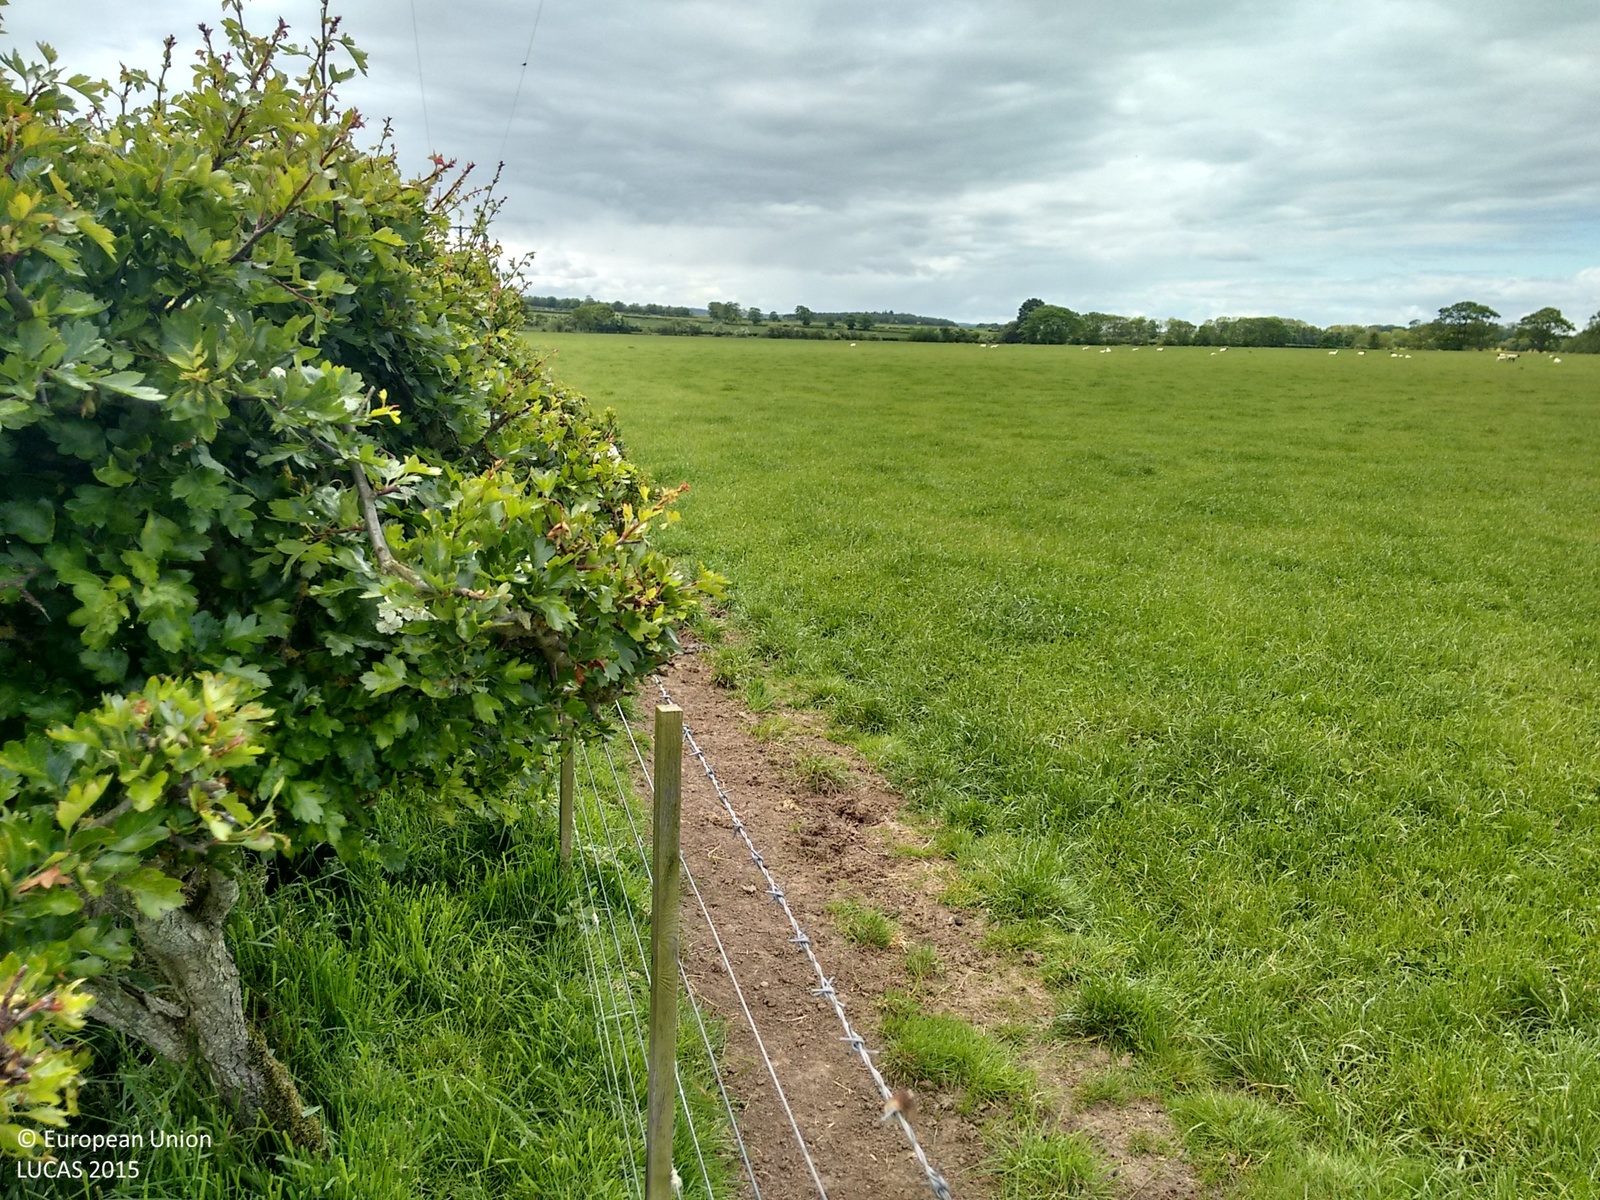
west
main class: Cropland
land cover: Temporary grasslands
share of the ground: > 75 %
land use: Agriculture (excluding fallow land and kitchen gardens)
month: June
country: GB
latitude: 55.5622
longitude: -1.6703
